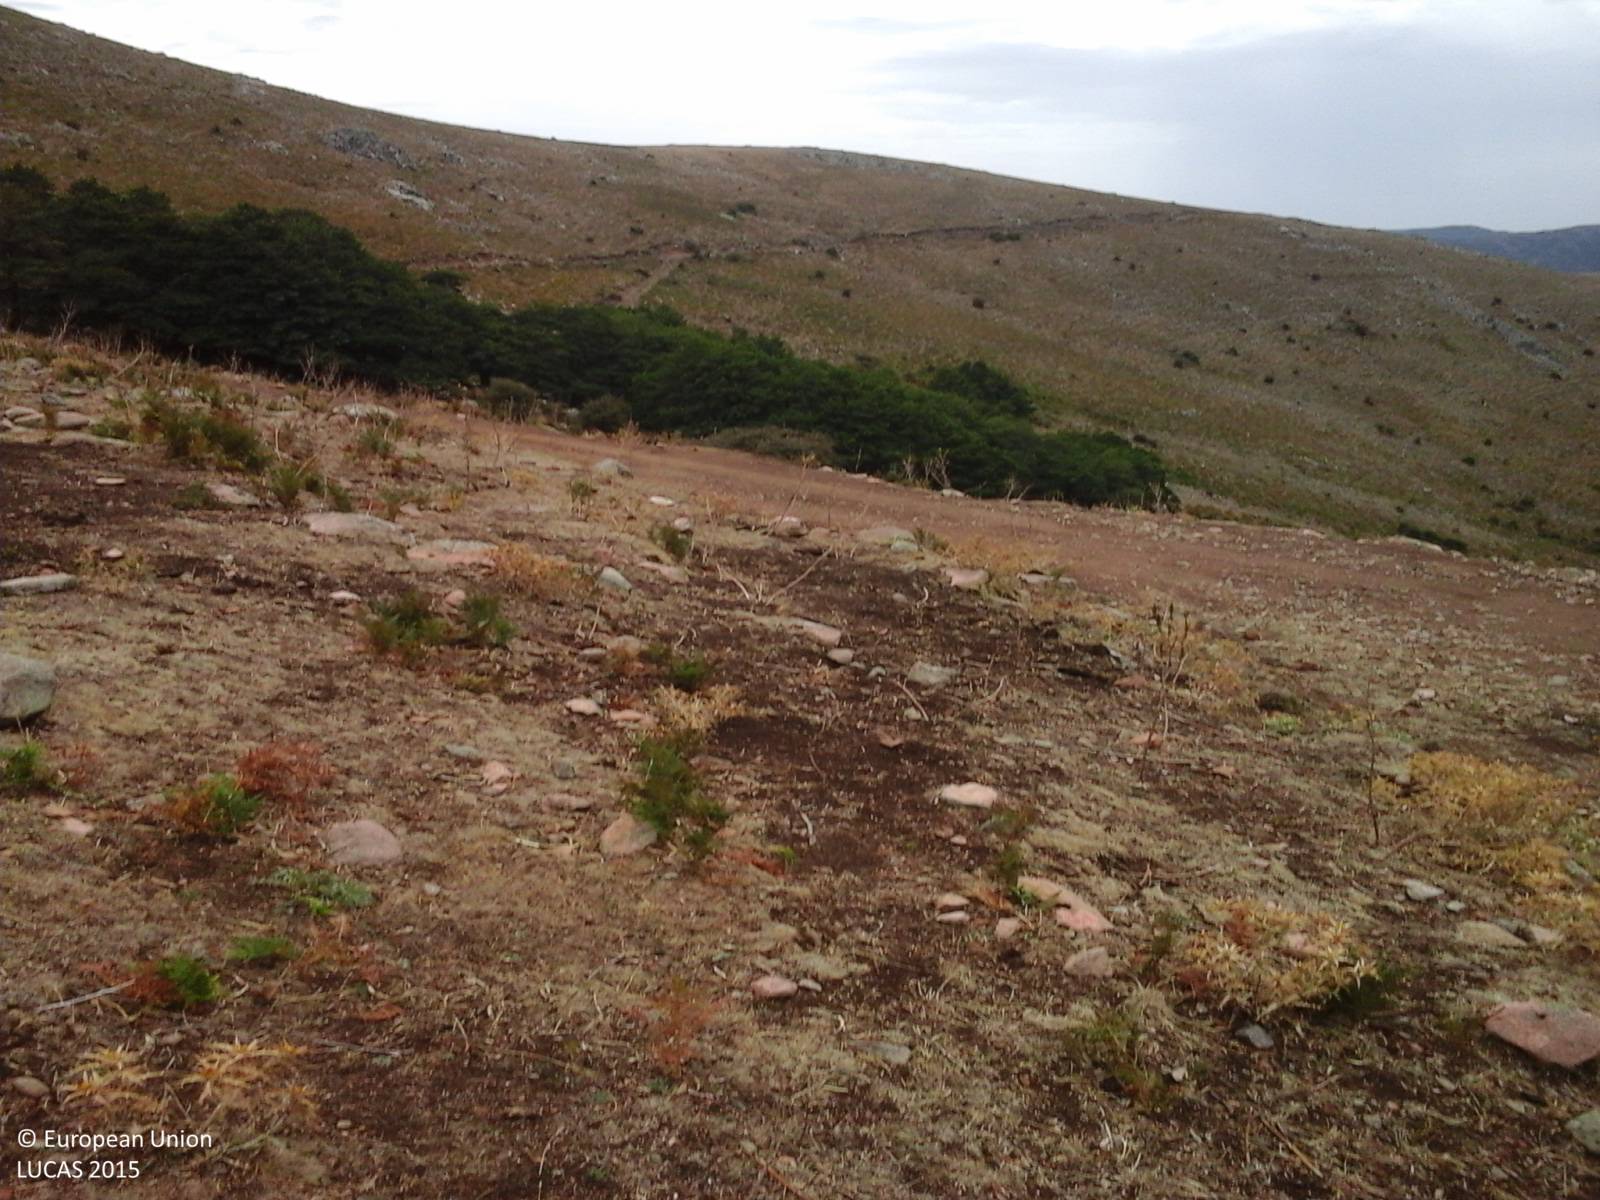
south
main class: Grassland
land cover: Grassland without tree/shrub cover
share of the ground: > 75 %
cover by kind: herbaceous plants 45 %, unconsolidated bare surface 45 %, consolidated bare surface 10 %
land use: Agriculture (excluding fallow land and kitchen gardens)
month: September
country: IT
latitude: 39.9571
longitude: 9.3132
